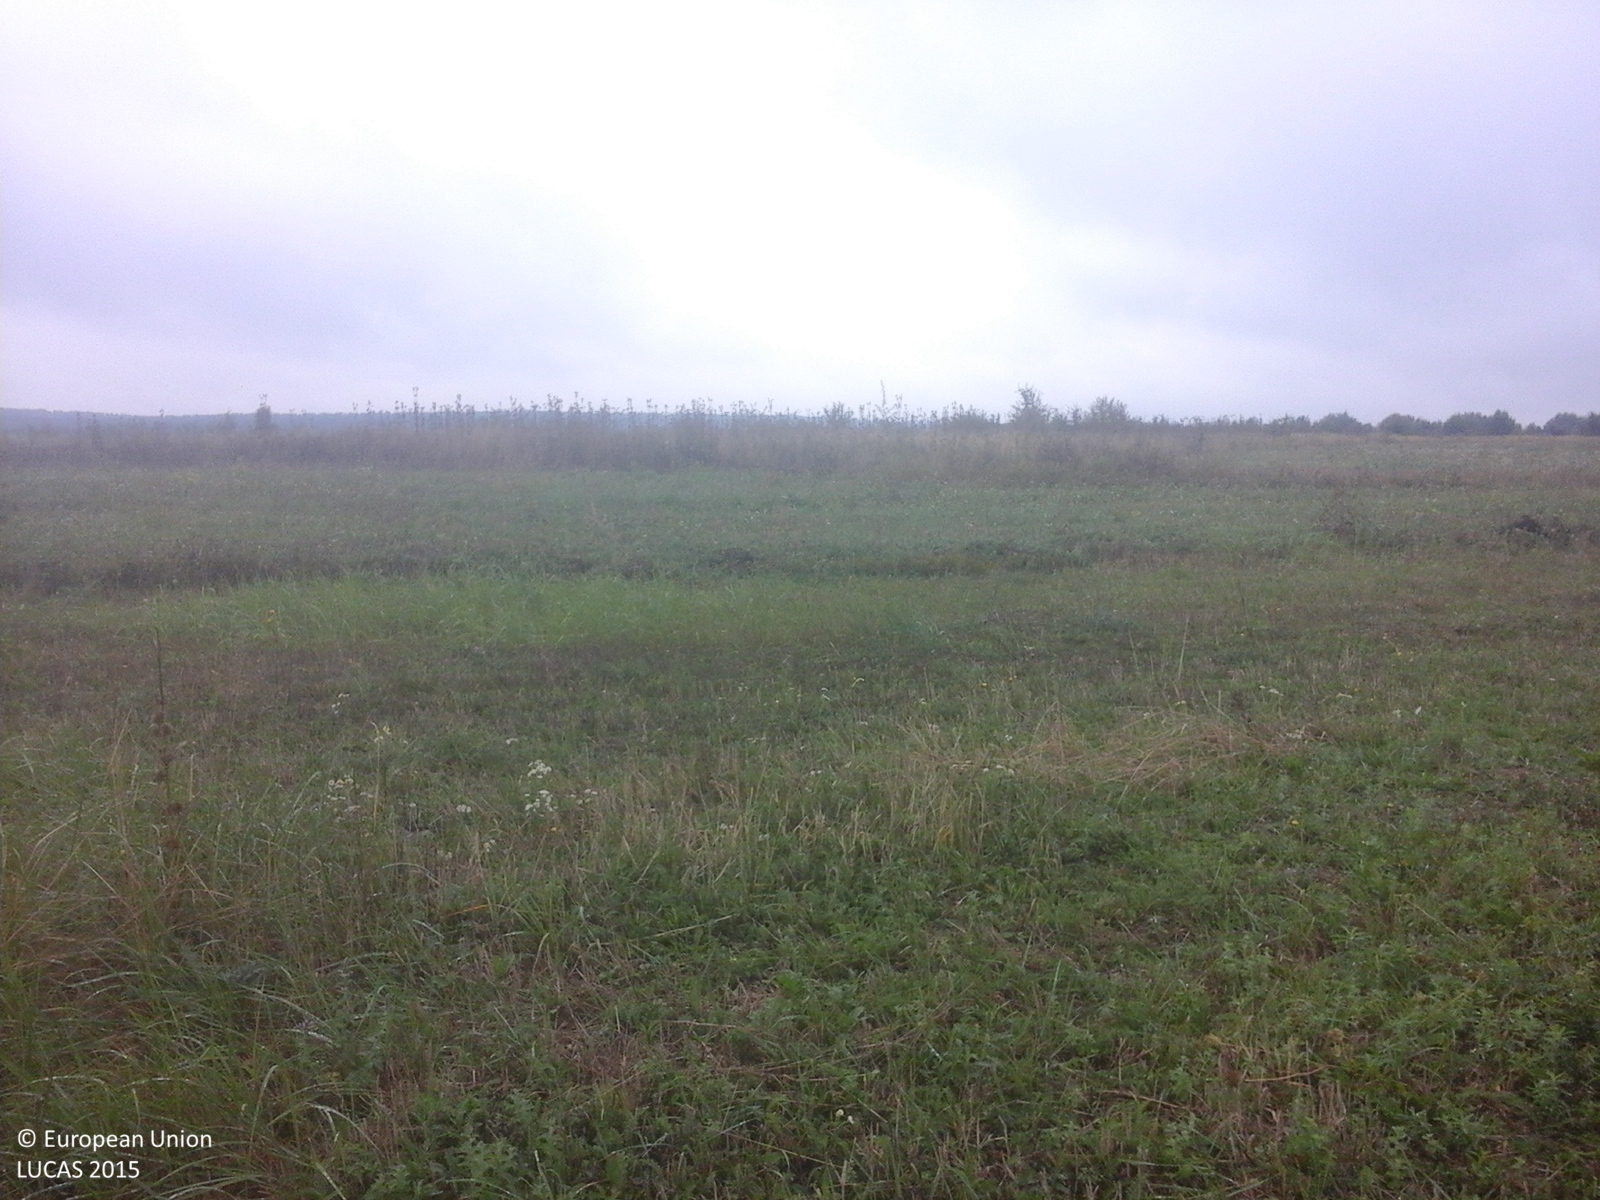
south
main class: Grassland
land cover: Grassland without tree/shrub cover
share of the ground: > 75 %
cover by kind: herbaceous plants 100 %
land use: Agriculture (excluding fallow land and kitchen gardens)
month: September
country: RO
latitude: 46.8151
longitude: 22.0386
